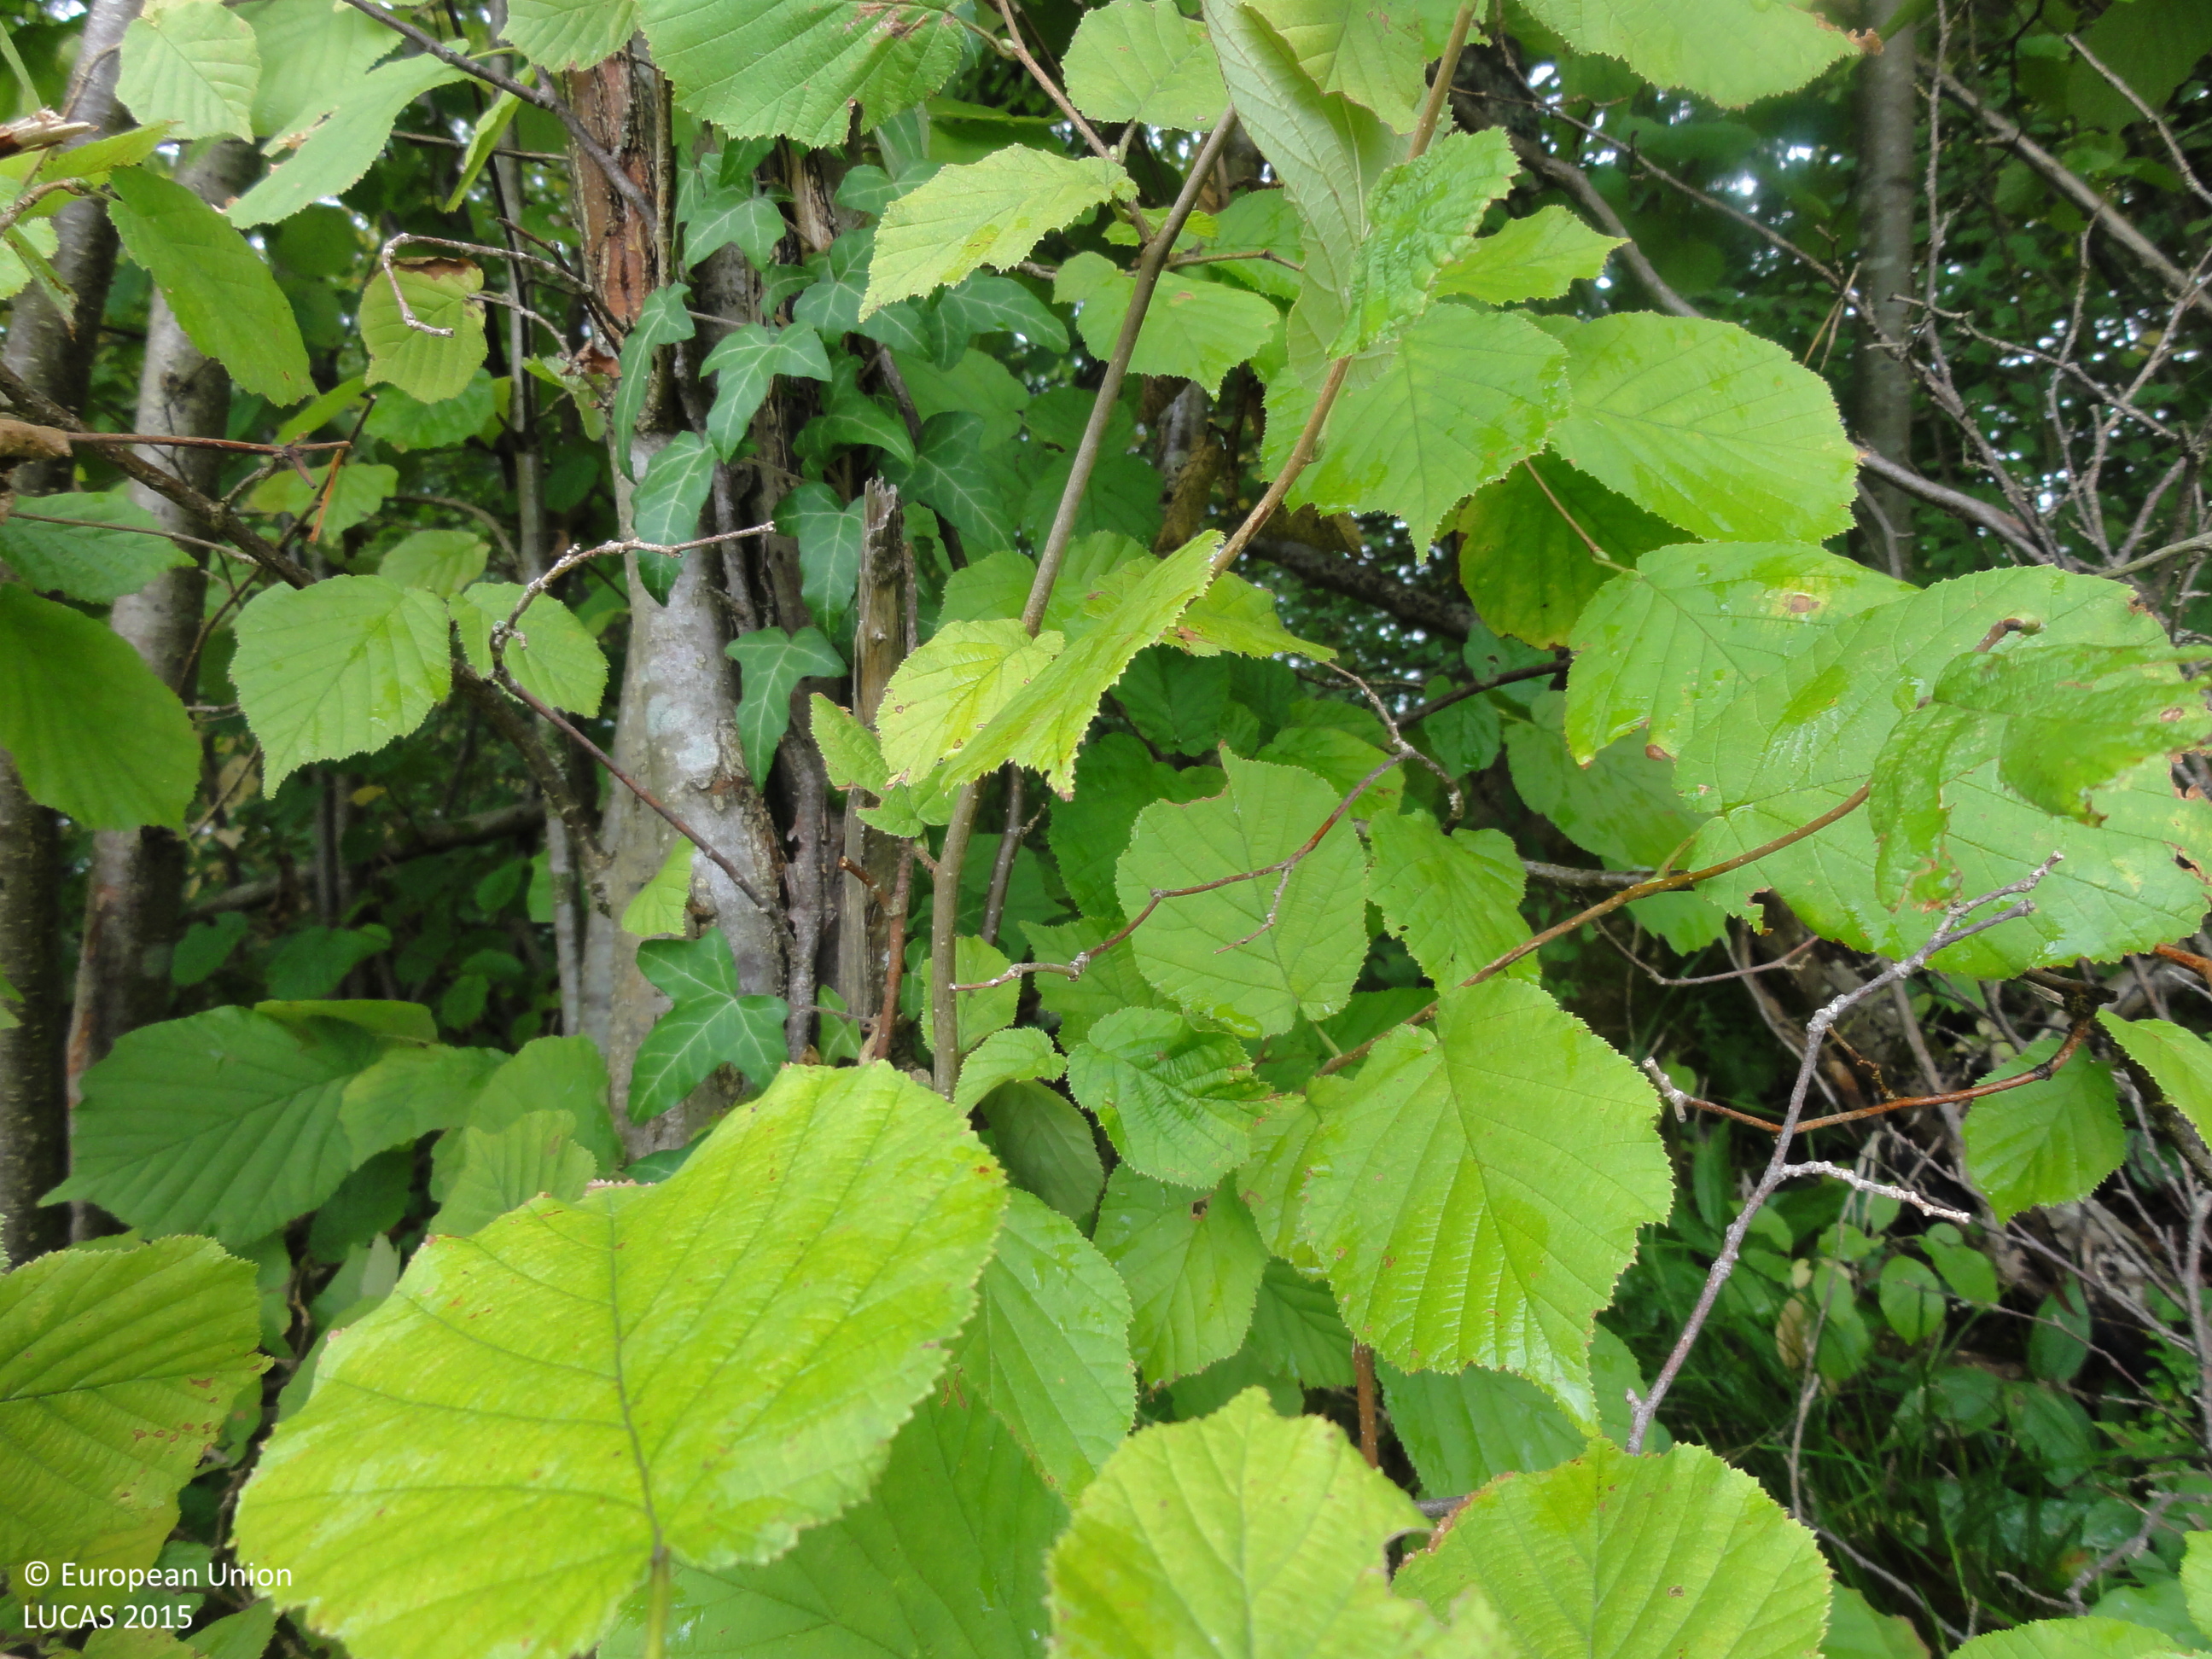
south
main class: Woodland
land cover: Broadleaved woodland
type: mesophytic deciduous forest
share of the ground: > 75 %
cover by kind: broadleaved forest trees 85 %, shrubs 10 %, coniferous forest trees 5 %
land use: Forestry
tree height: > 5 m
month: August
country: SI
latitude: 45.9939
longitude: 15.1226
